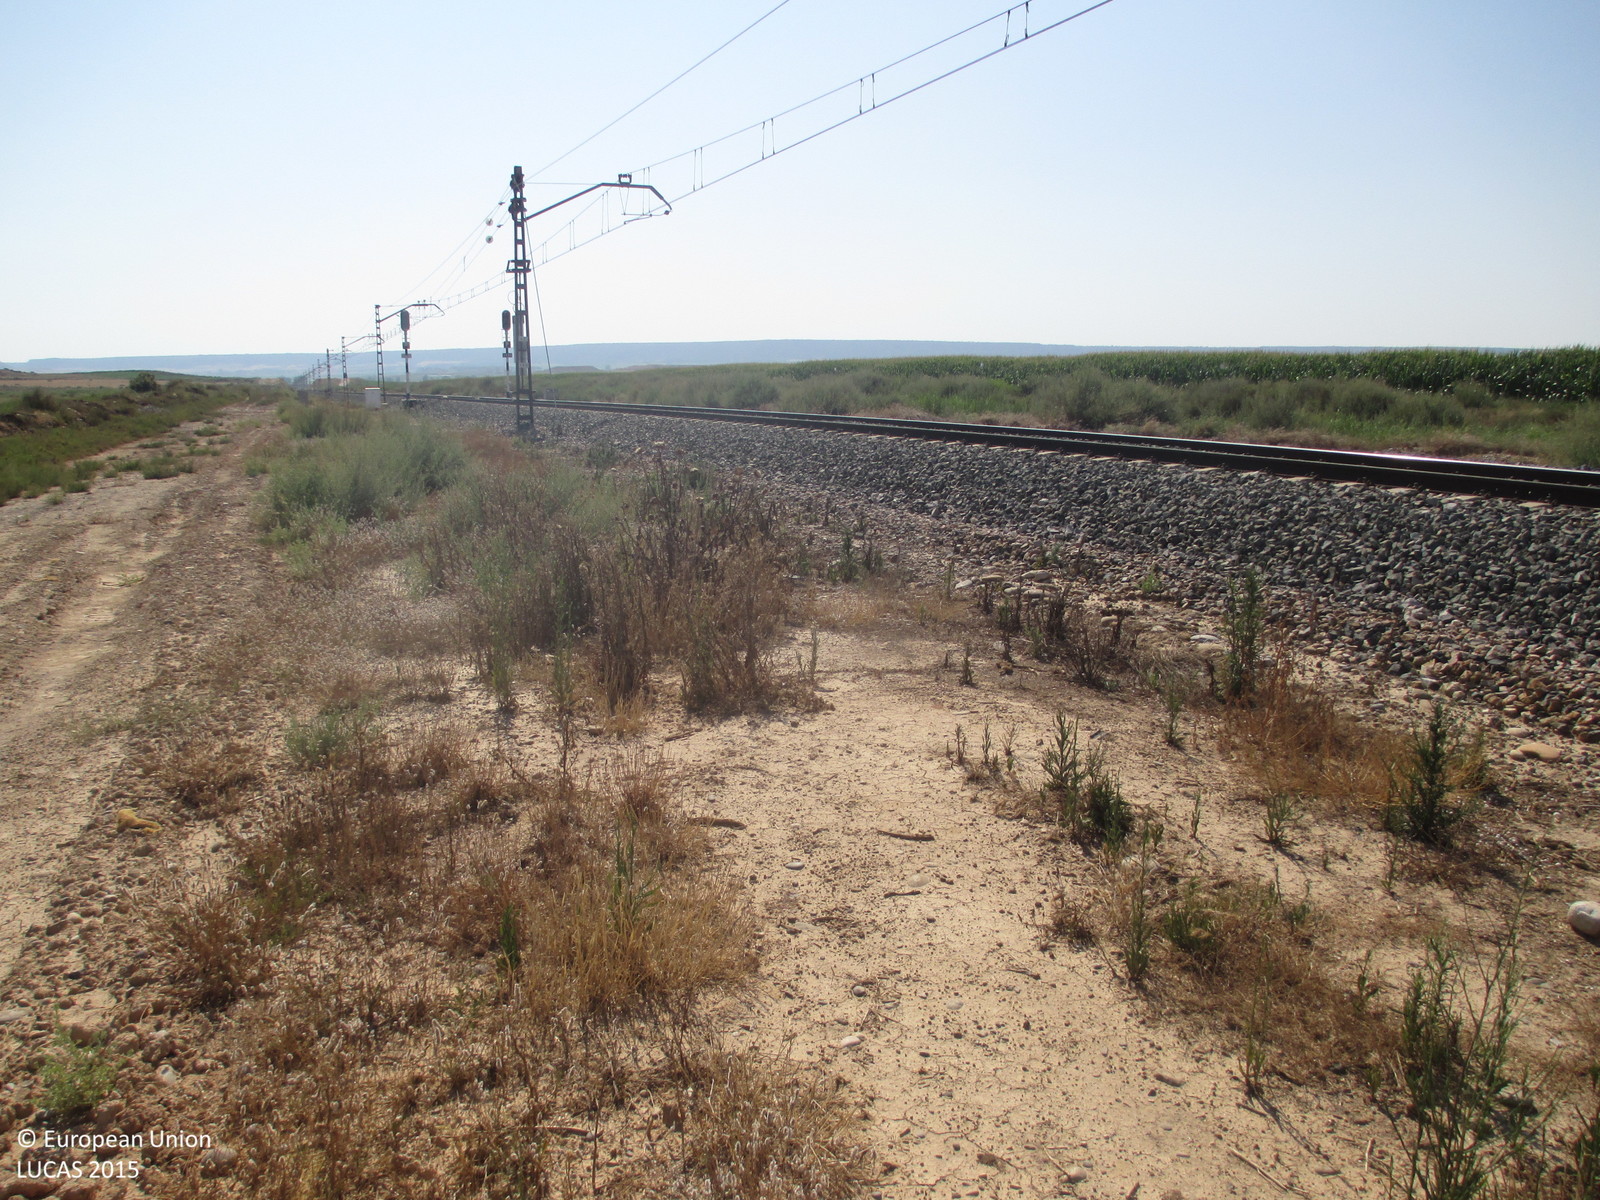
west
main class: Grassland
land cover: Spontaneously vegetated surfaces
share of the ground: 10 - 25 %
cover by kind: unconsolidated bare surface 65 %, herbaceous plants 15 %
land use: Railway transport
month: July
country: ES
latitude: 41.8962
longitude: 0.1112
